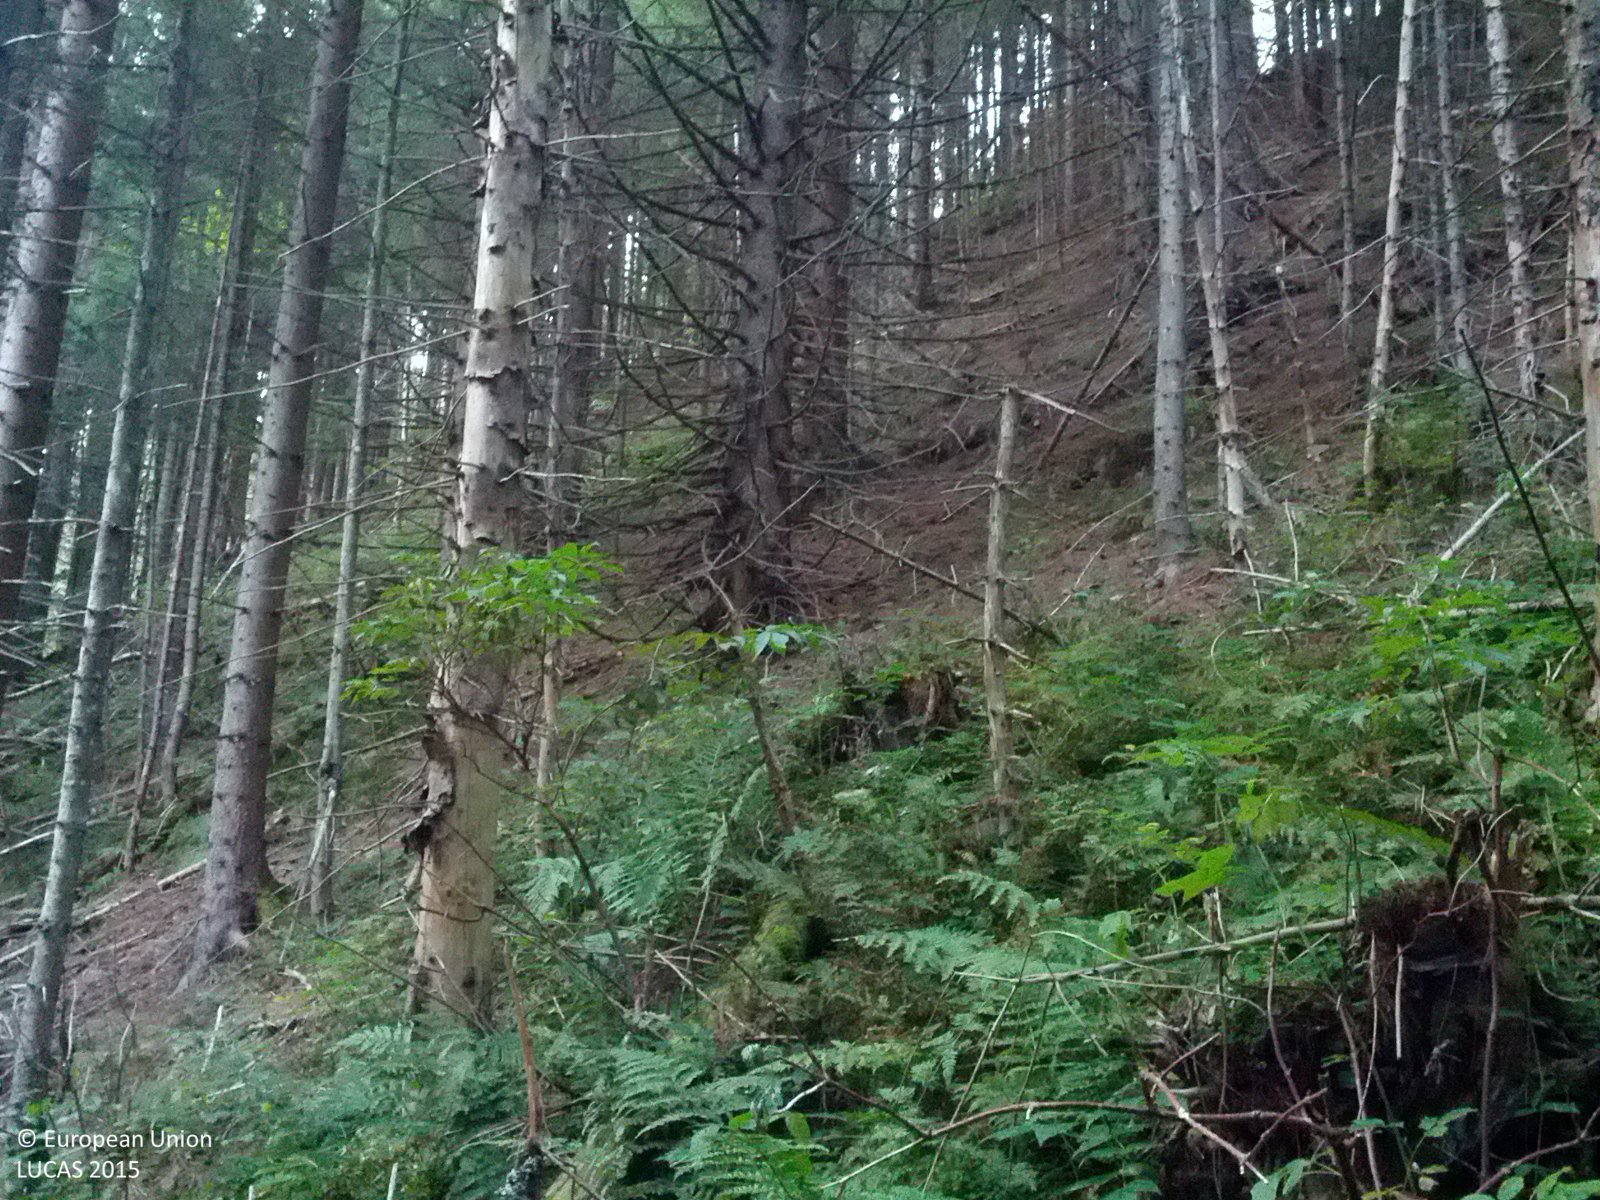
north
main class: Woodland
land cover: Spruce dominated coniferous woodland
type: alpine coniferous forest
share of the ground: > 75 %
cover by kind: coniferous forest trees 90 %, herbaceous plants 5 %, unconsolidated bare surface 5 %
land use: Forestry
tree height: > 5 m
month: September
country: AT
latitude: 47.4282
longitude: 13.5380
